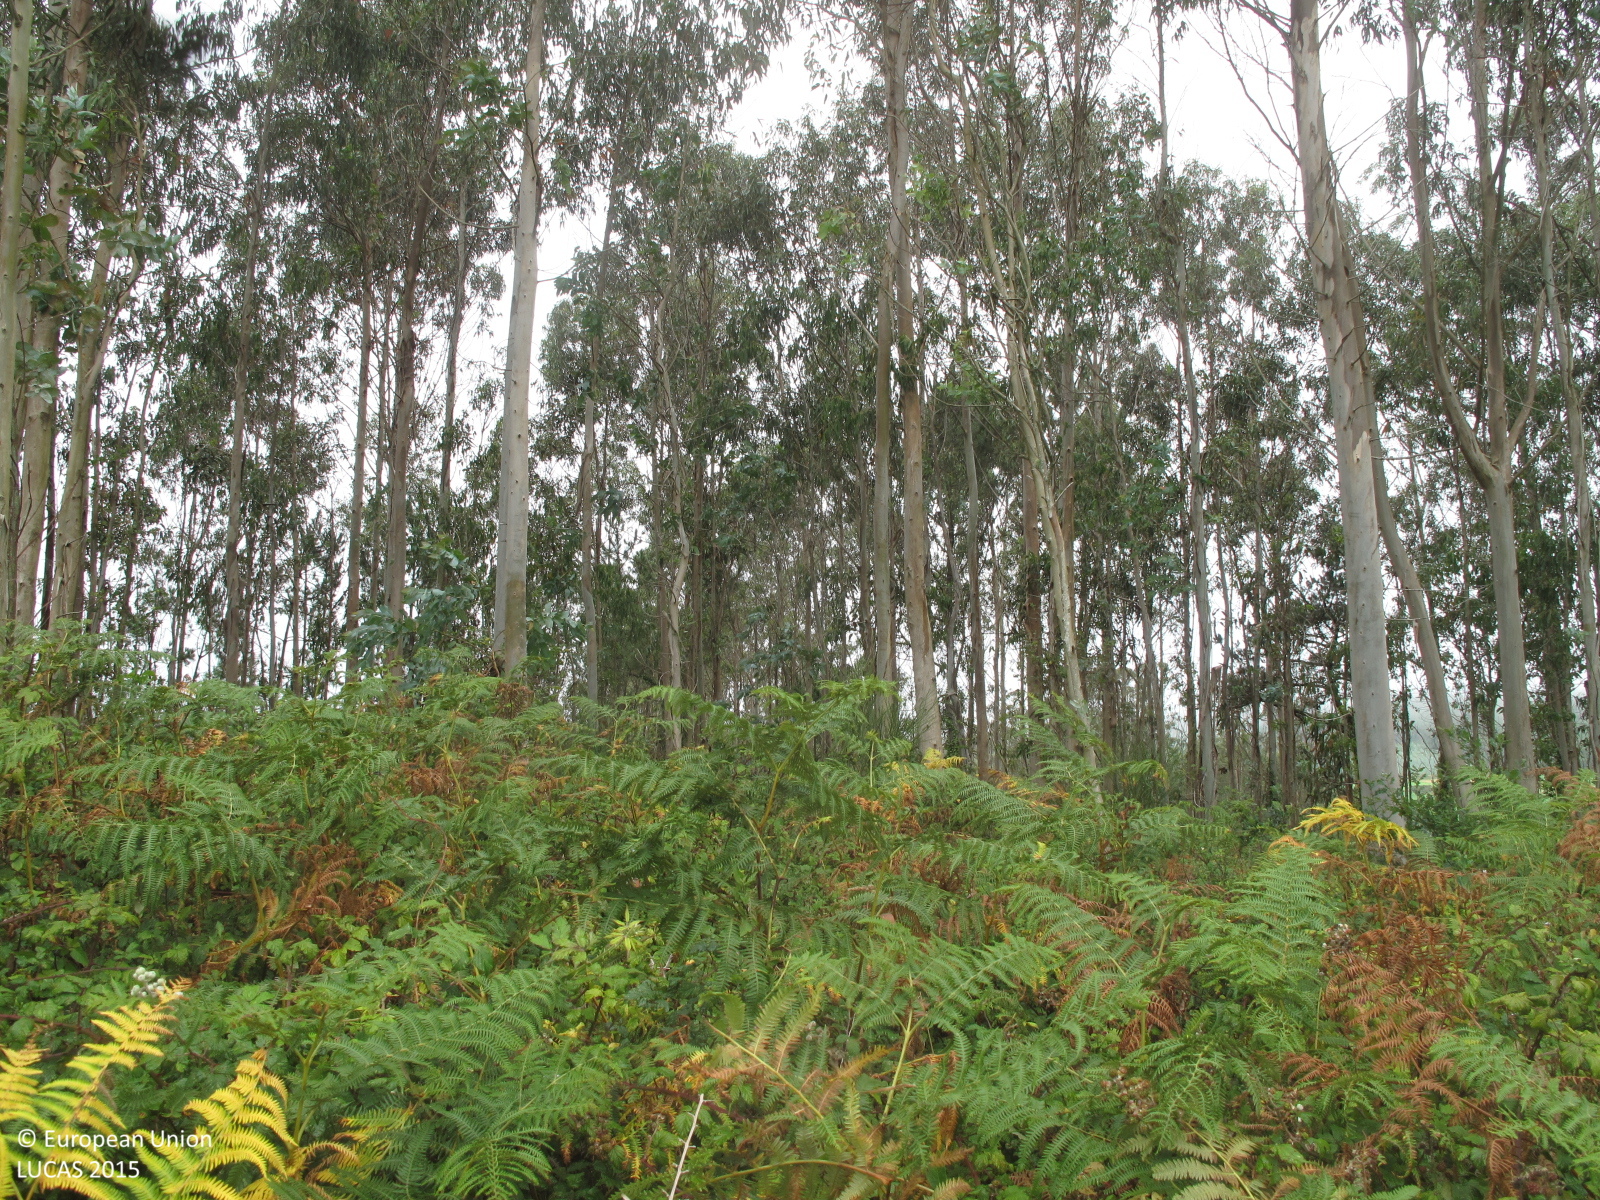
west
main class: Woodland
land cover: Broadleaved woodland
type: exotic forest
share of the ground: 50 - 75 %
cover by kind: broadleaved forest trees 50 %, shrubs 30 %, herbaceous plants 20 %
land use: Forestry
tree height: > 5 m
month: July
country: ES
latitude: 43.0289
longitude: -9.2378
